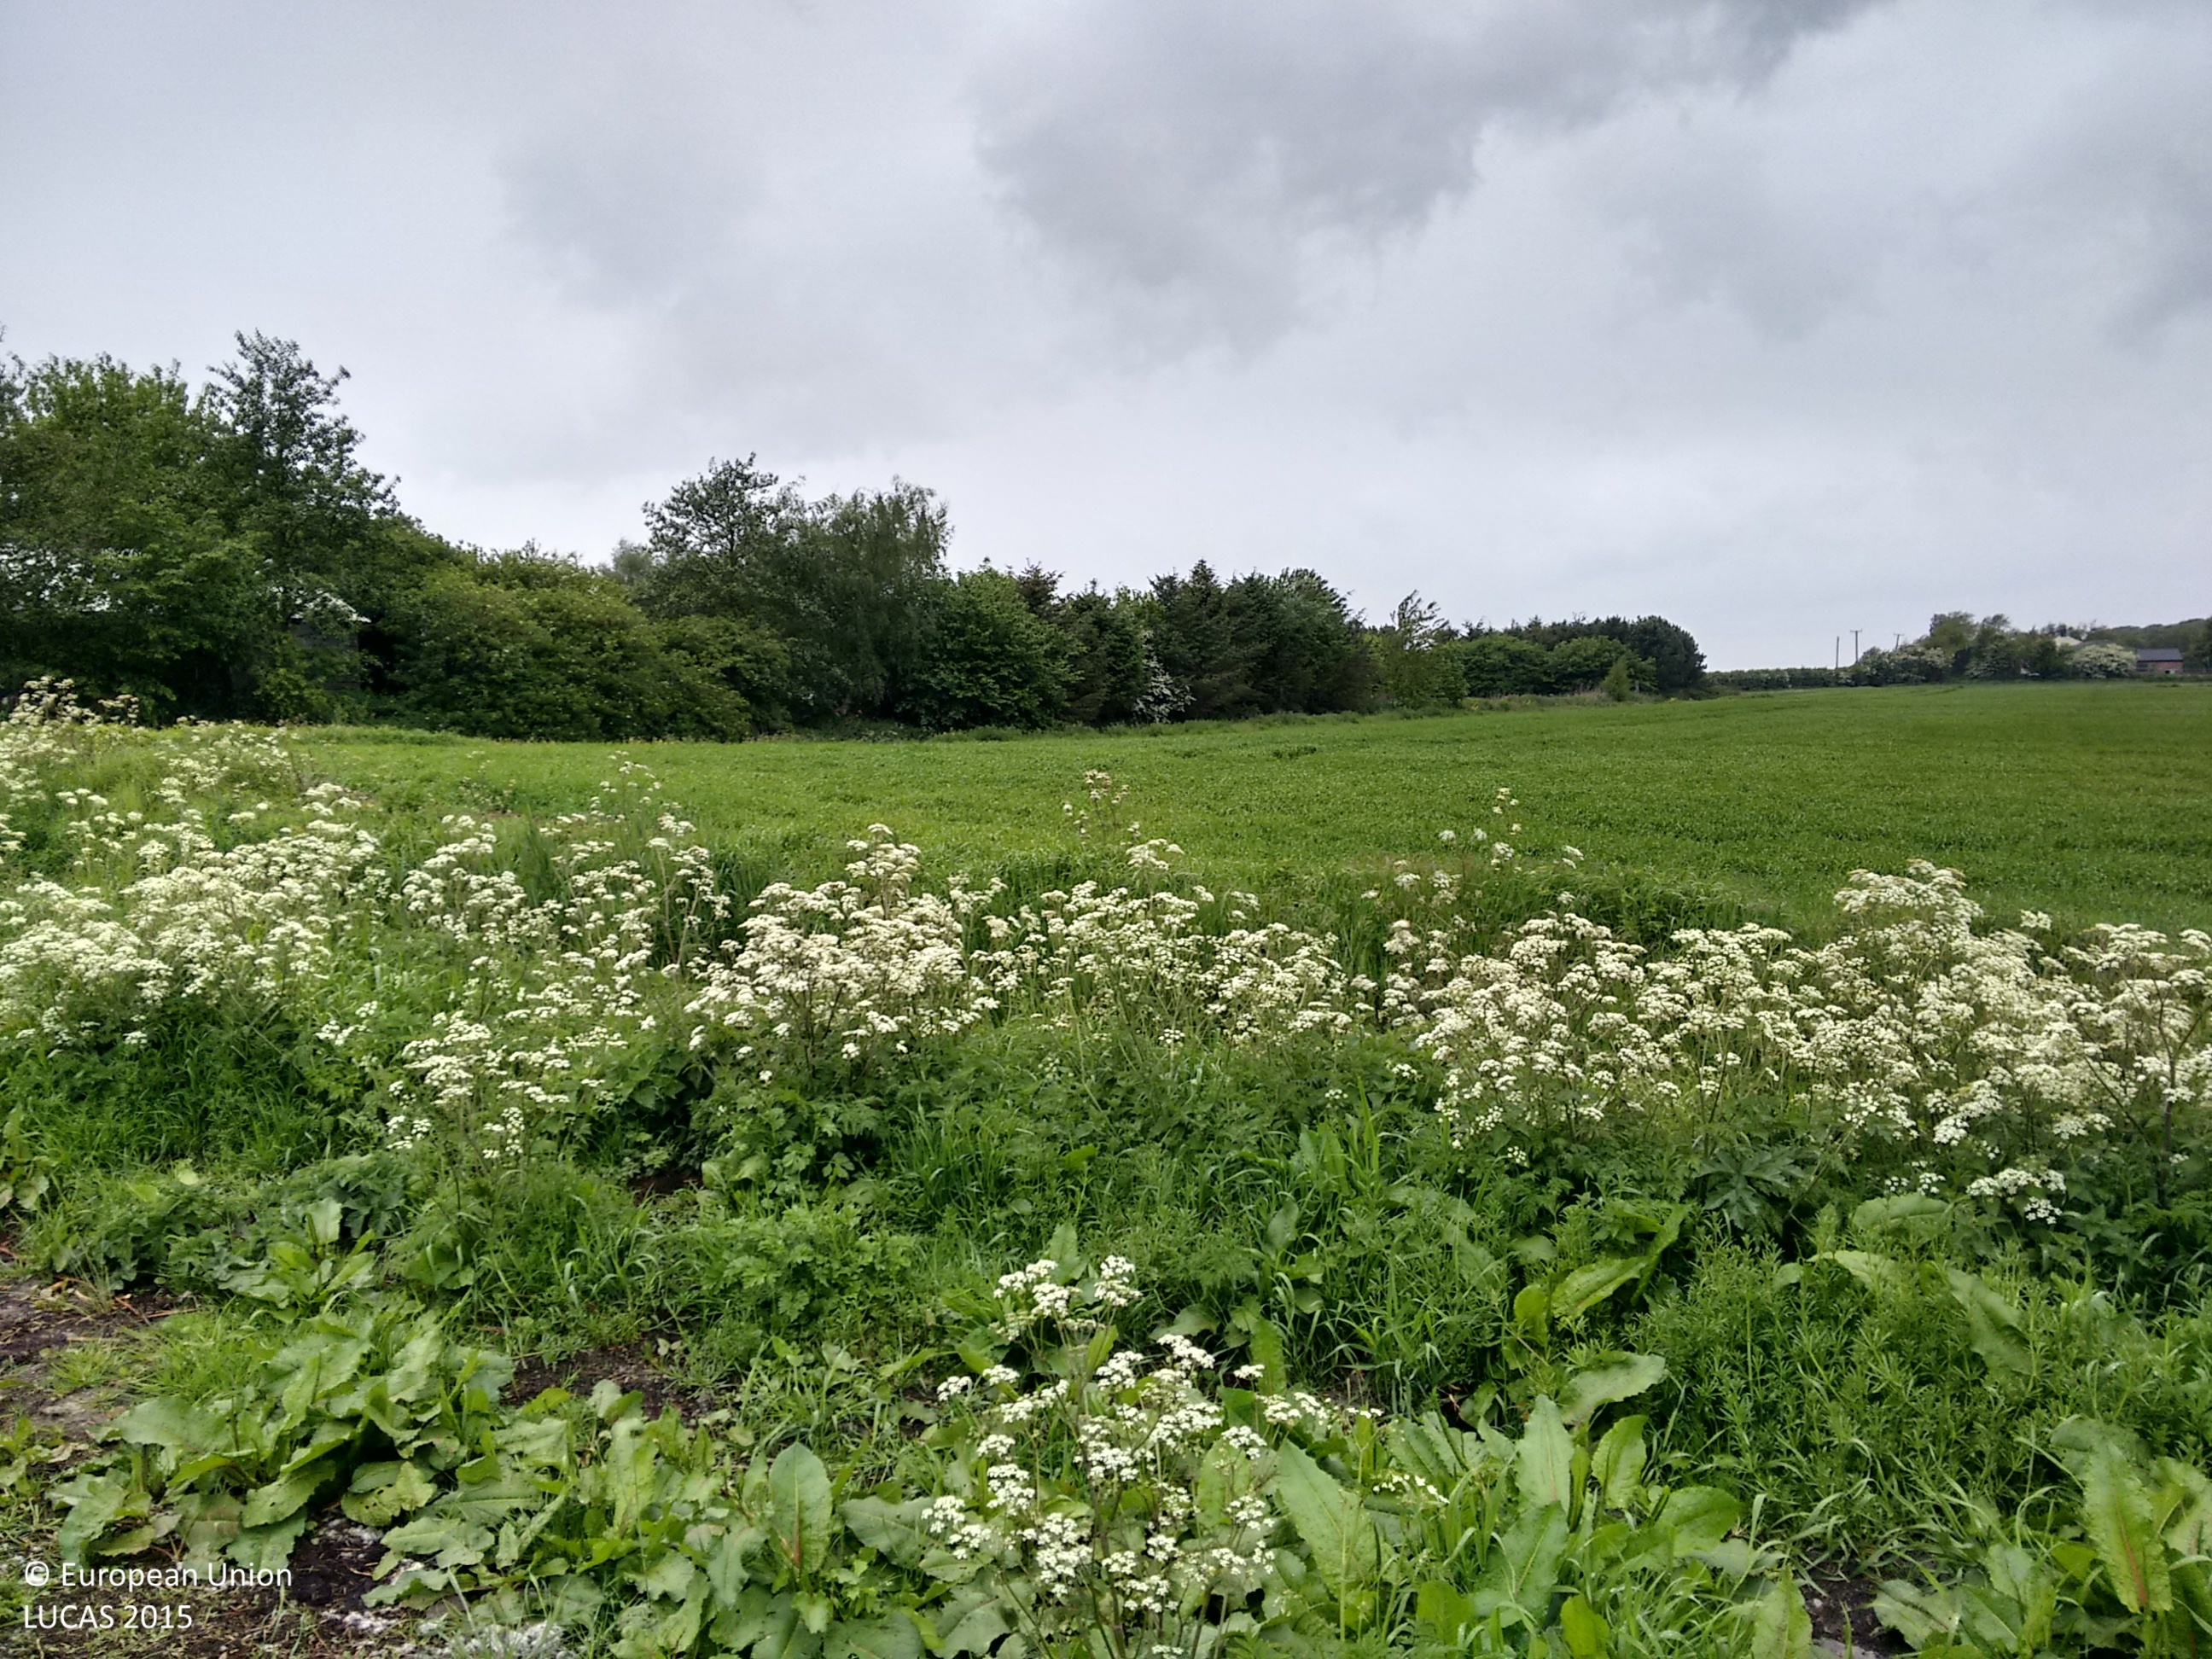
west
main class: Grassland
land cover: Grassland without tree/shrub cover
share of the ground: > 75 %
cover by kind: herbaceous plants 100 %
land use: Agriculture (excluding fallow land and kitchen gardens)
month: May
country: GB
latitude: 53.6361
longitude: -2.9127
